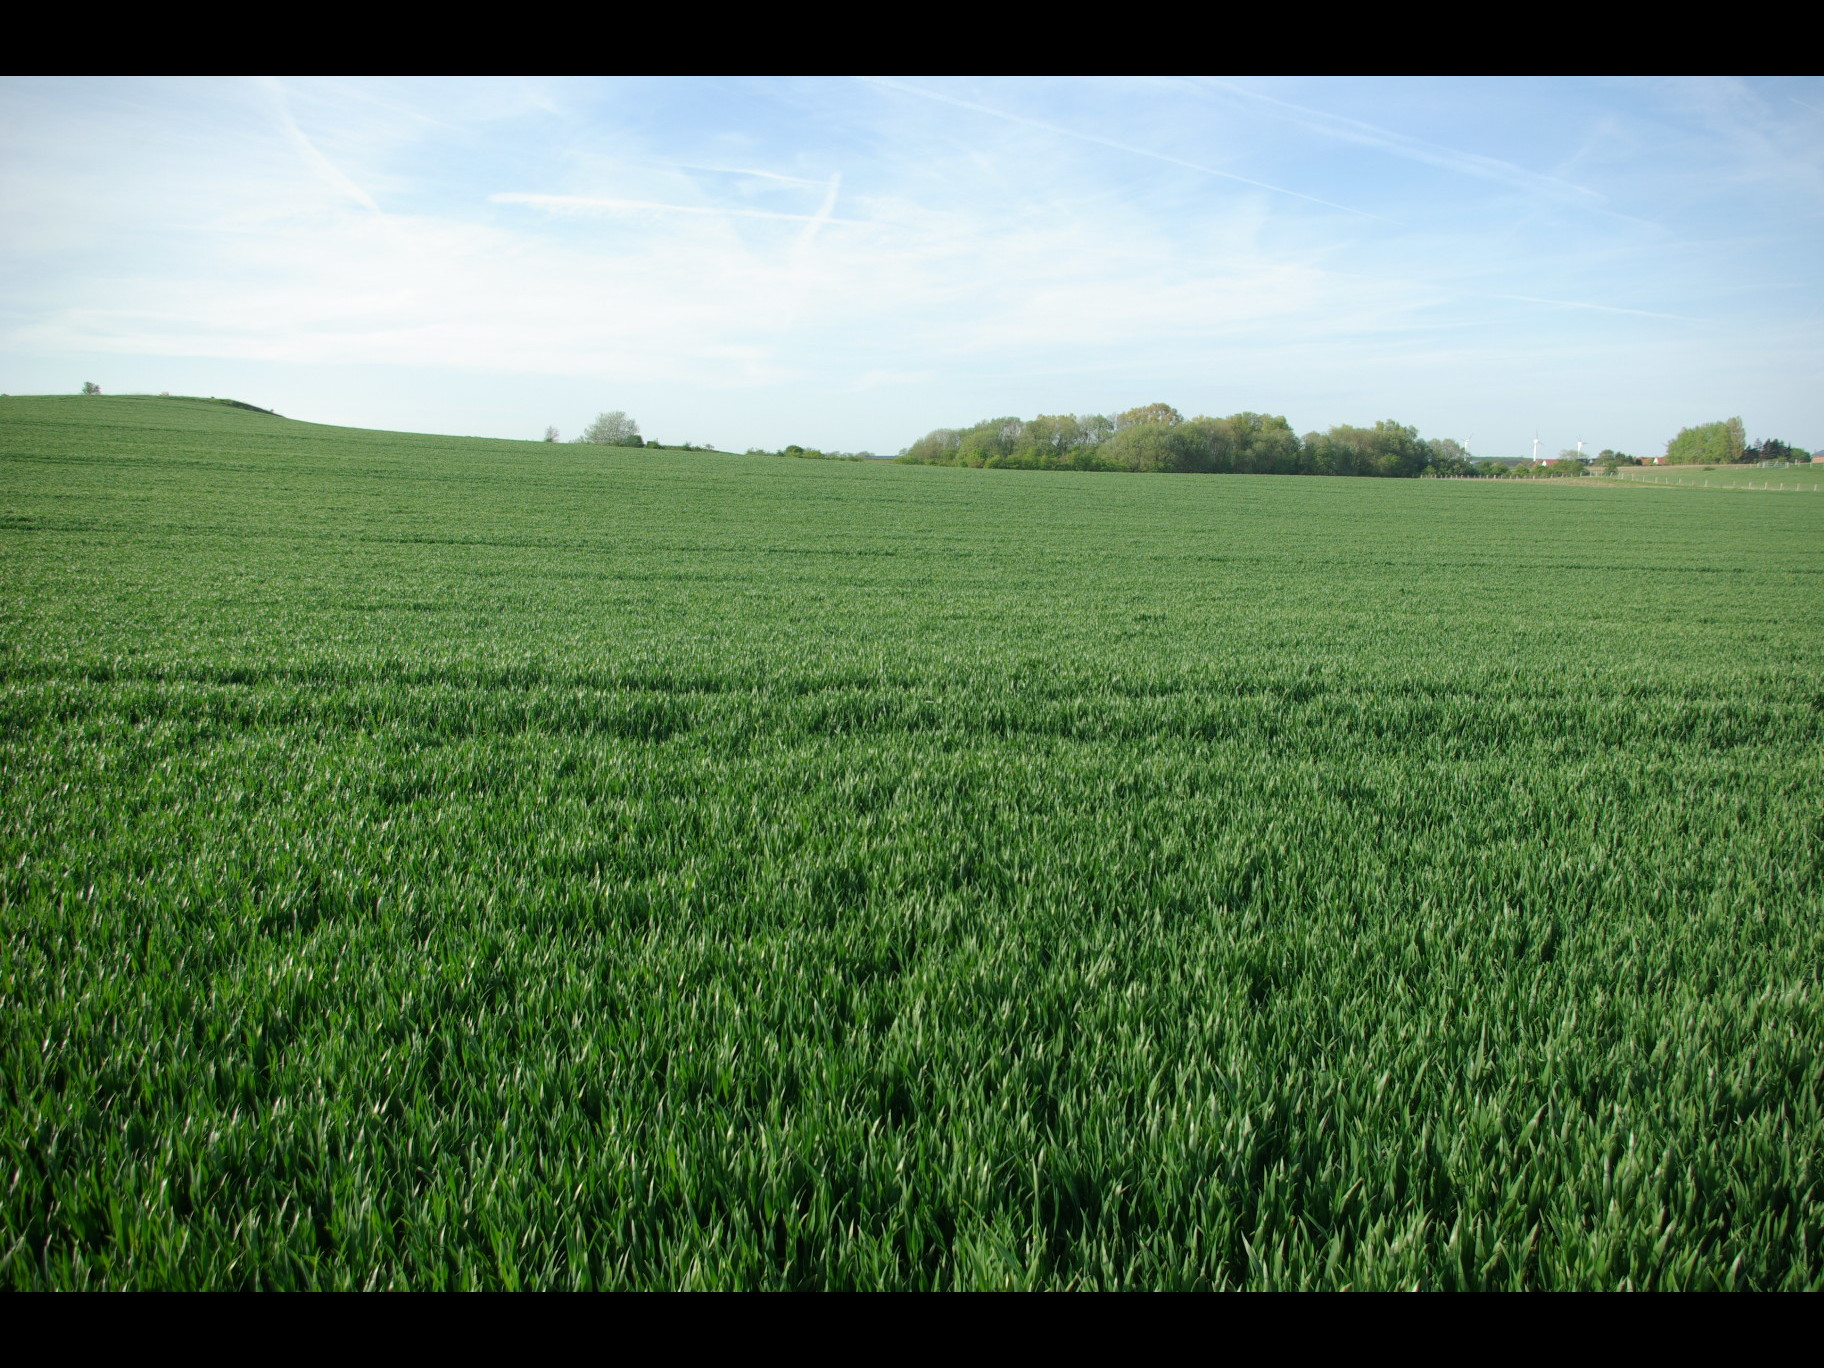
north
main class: Cropland
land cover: Common wheat
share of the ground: > 75 %
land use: Agriculture (excluding fallow land and kitchen gardens)
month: May
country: DE
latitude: 54.4030
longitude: 11.1547
